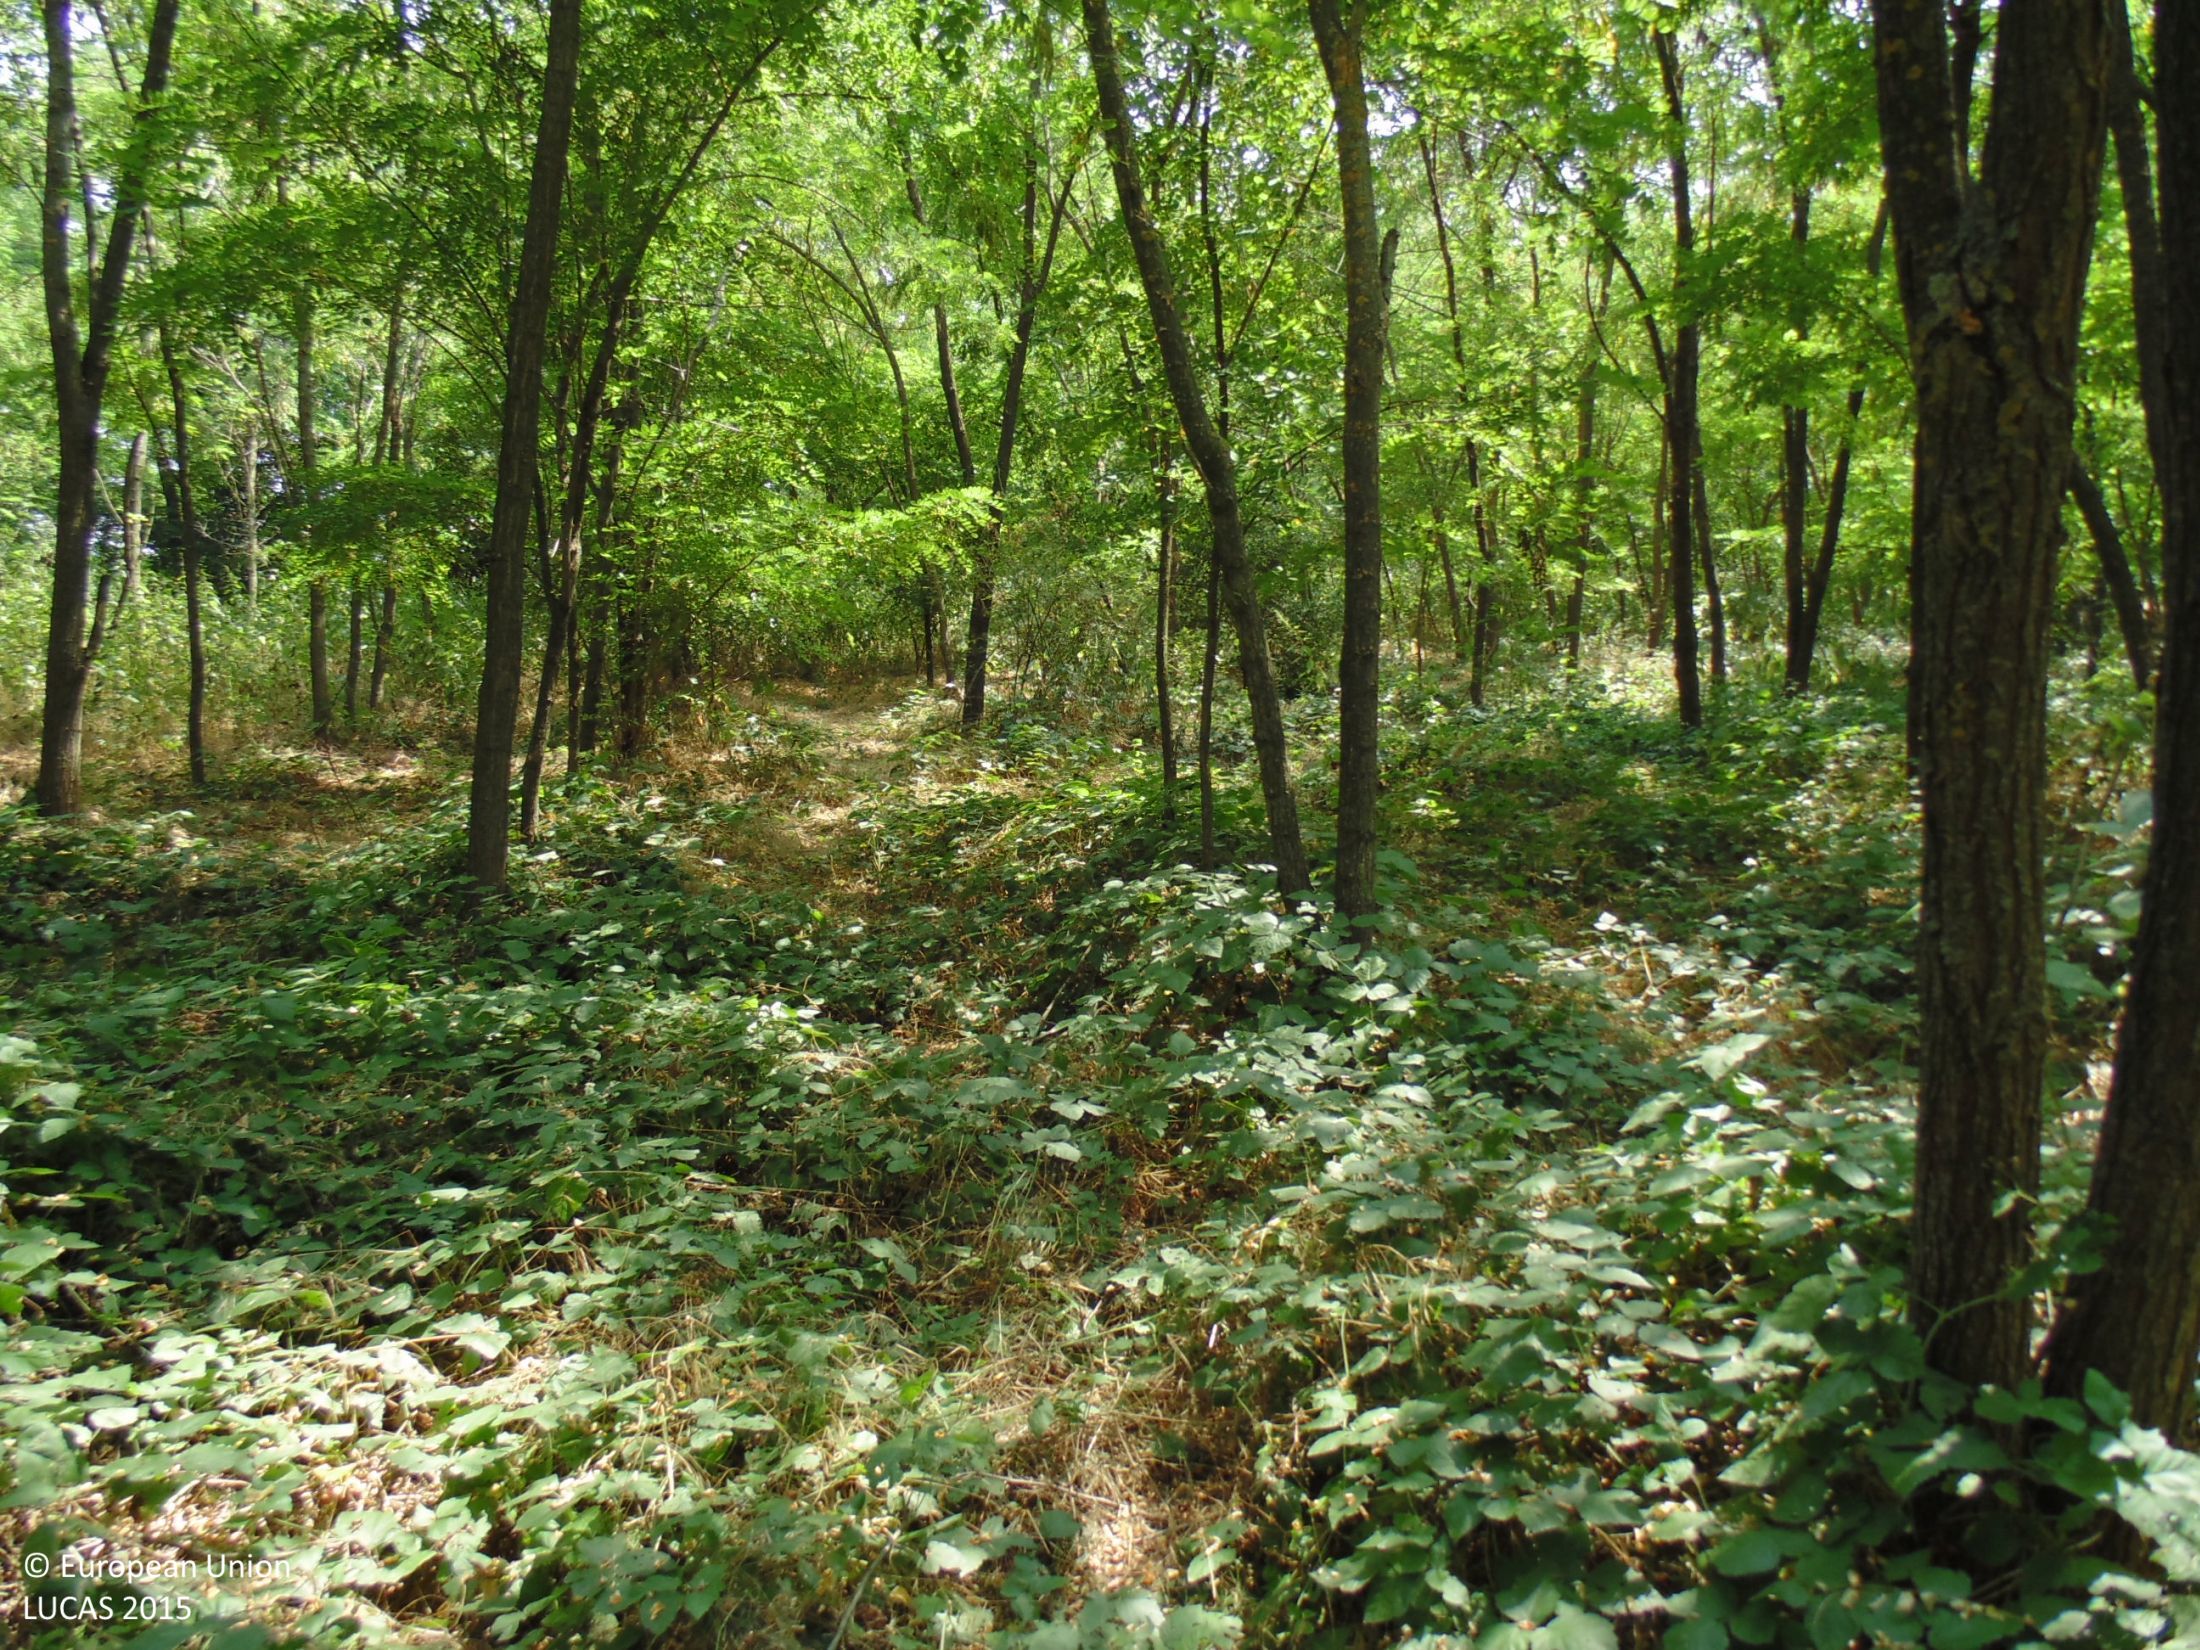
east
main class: Woodland
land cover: Broadleaved woodland
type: exotic forest
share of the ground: > 75 %
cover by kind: broadleaved forest trees 90 %, shrubs 5 %, herbaceous plants 5 %
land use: Forestry
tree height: > 5 m
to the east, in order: Broadleaved woodland; Grass margins; Tracks; Maize; Grass margins; Broadleaved woodland; Grass margins; Common wheat
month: July
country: BG
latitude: 43.6656
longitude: 27.9931
